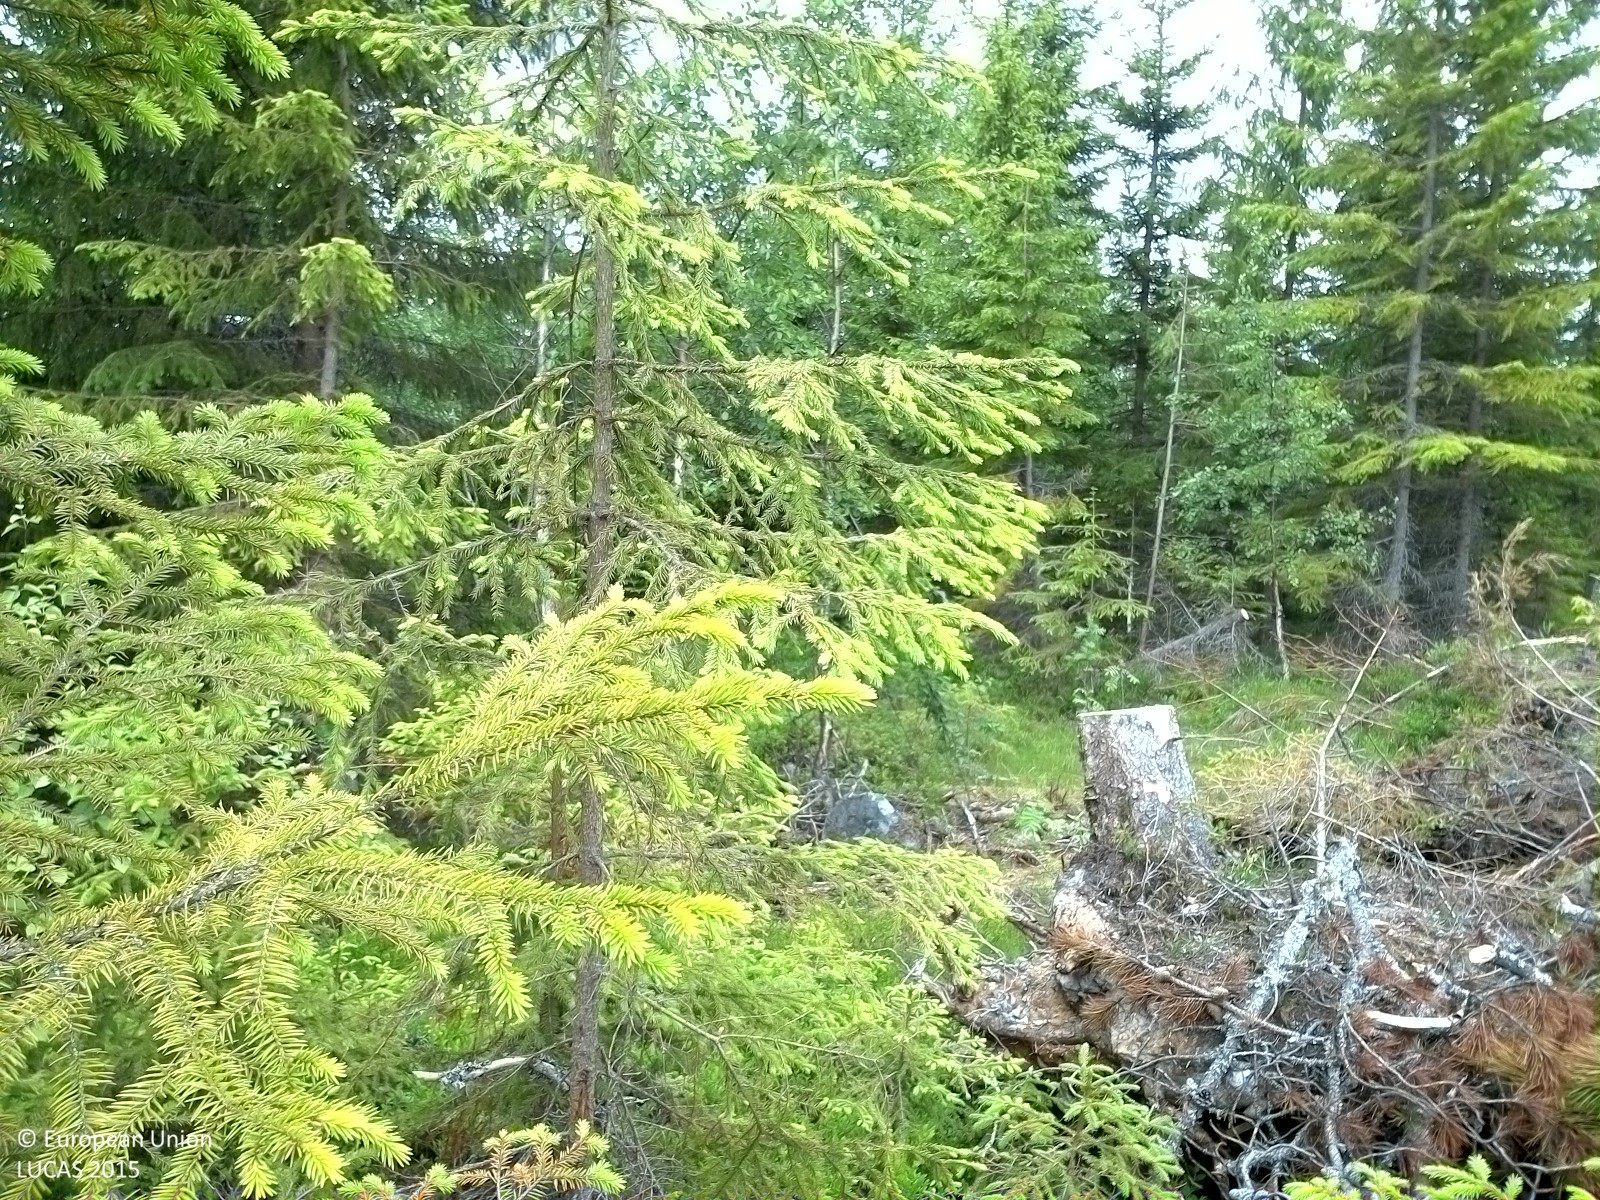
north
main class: Woodland
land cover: Other coniferous woodland
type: boreal forest
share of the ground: 10 - 25 %
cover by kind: coniferous forest trees 25 %, herbaceous plants 25 %
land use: Forestry
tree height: < 5 m
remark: Clear cut
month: June
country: SE
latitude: 62.0263
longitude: 16.3452
